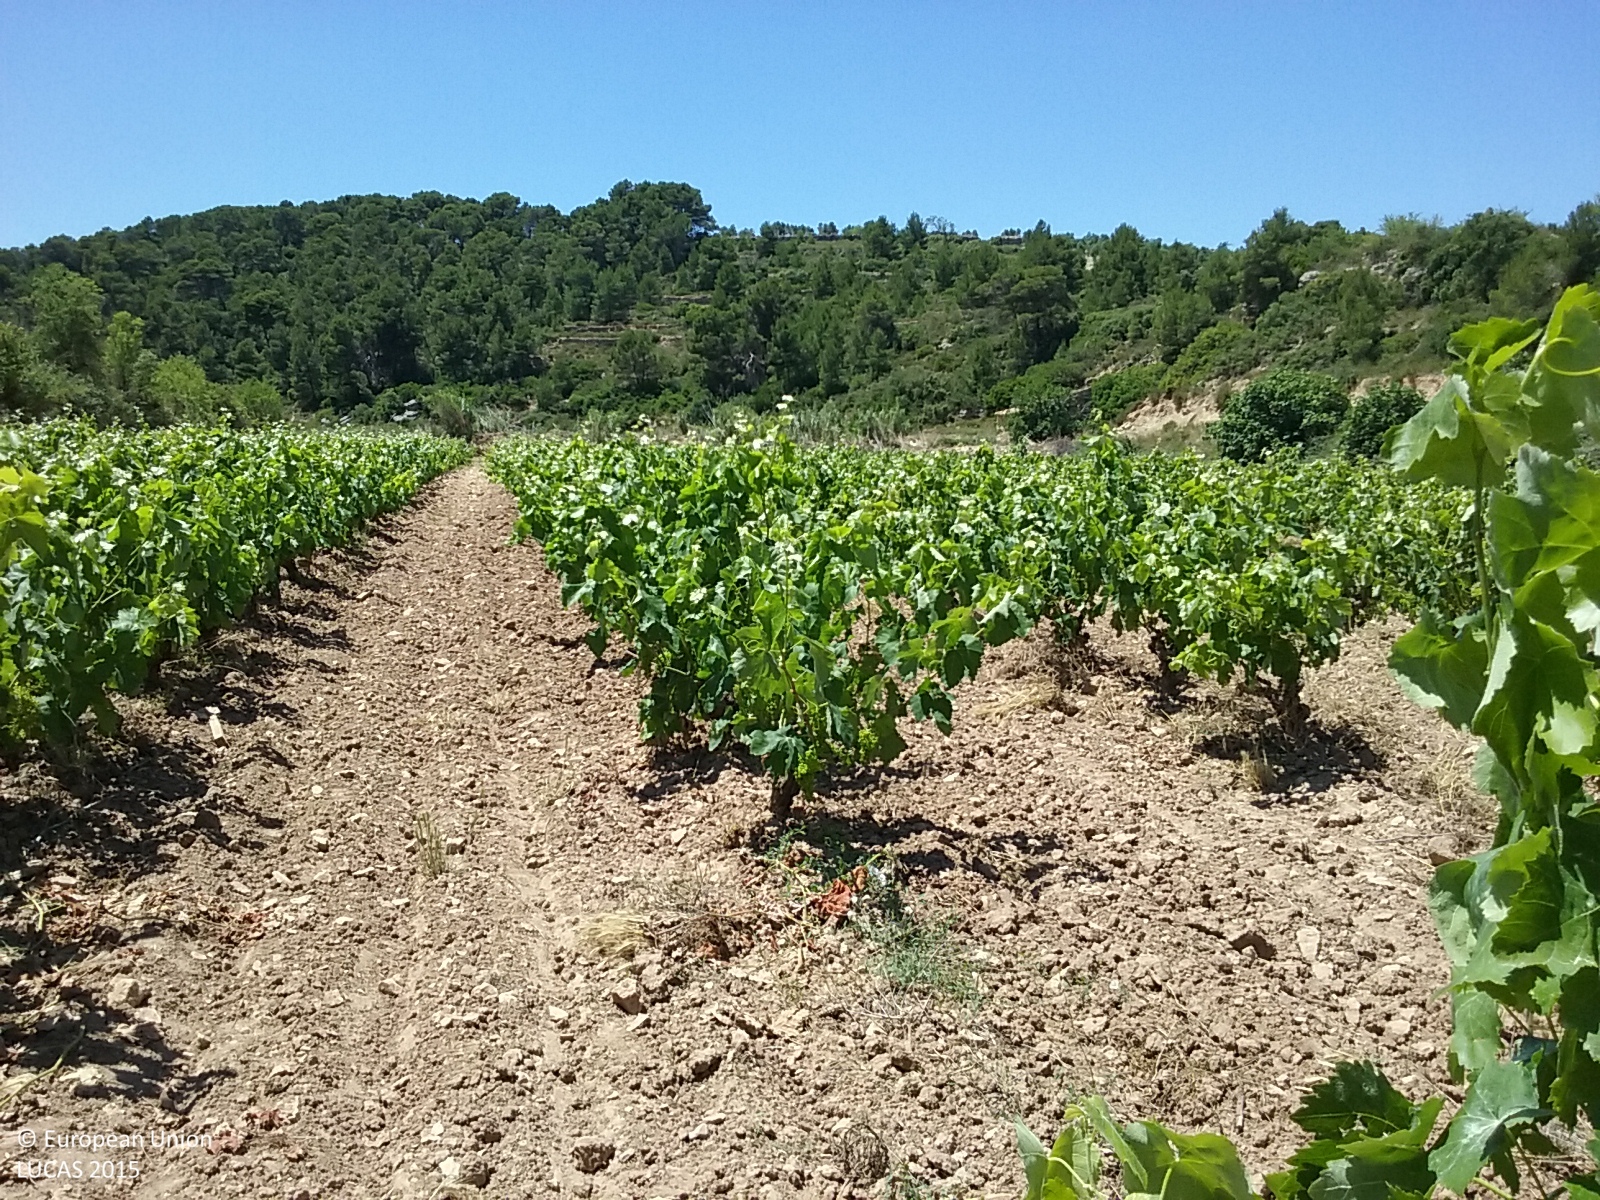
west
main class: Cropland
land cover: Vineyards
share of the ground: < 10 %
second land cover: Other bare soil
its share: > 75 %
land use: Agriculture (excluding fallow land and kitchen gardens)
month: June
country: ES
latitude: 41.1043
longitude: 0.3816
